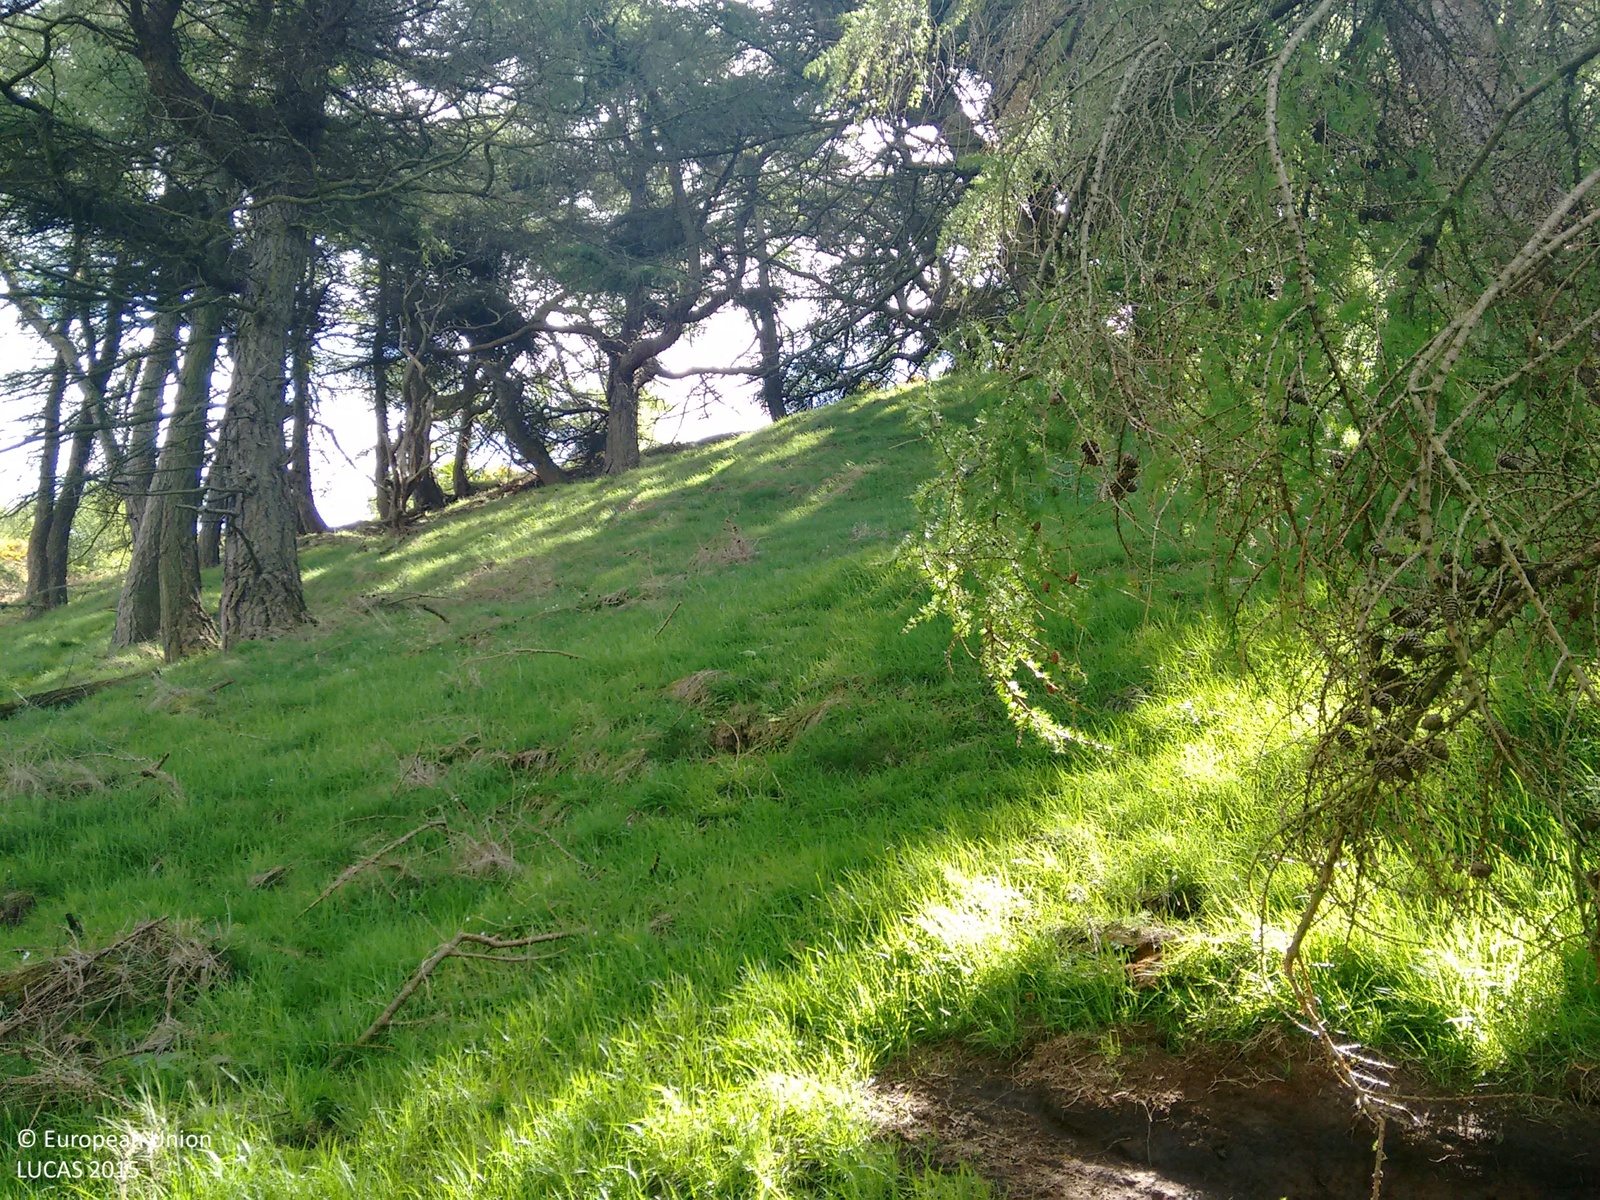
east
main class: Woodland
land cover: Pine dominated coniferous woodland
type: exotic forest
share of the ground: > 75 %
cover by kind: coniferous forest trees 100 %
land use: Semi-natural and natural areas not in use
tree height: > 5 m
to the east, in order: Pine dominated coniferous woodland; Grass margins; Tracks; Grass margins; Dry stone walls; Fences; Grassland without tree/shrub cover; Fences; Dry stone walls; Grassland without tree/shrub cover
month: May
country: GB
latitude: 54.0799
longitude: -2.6777
